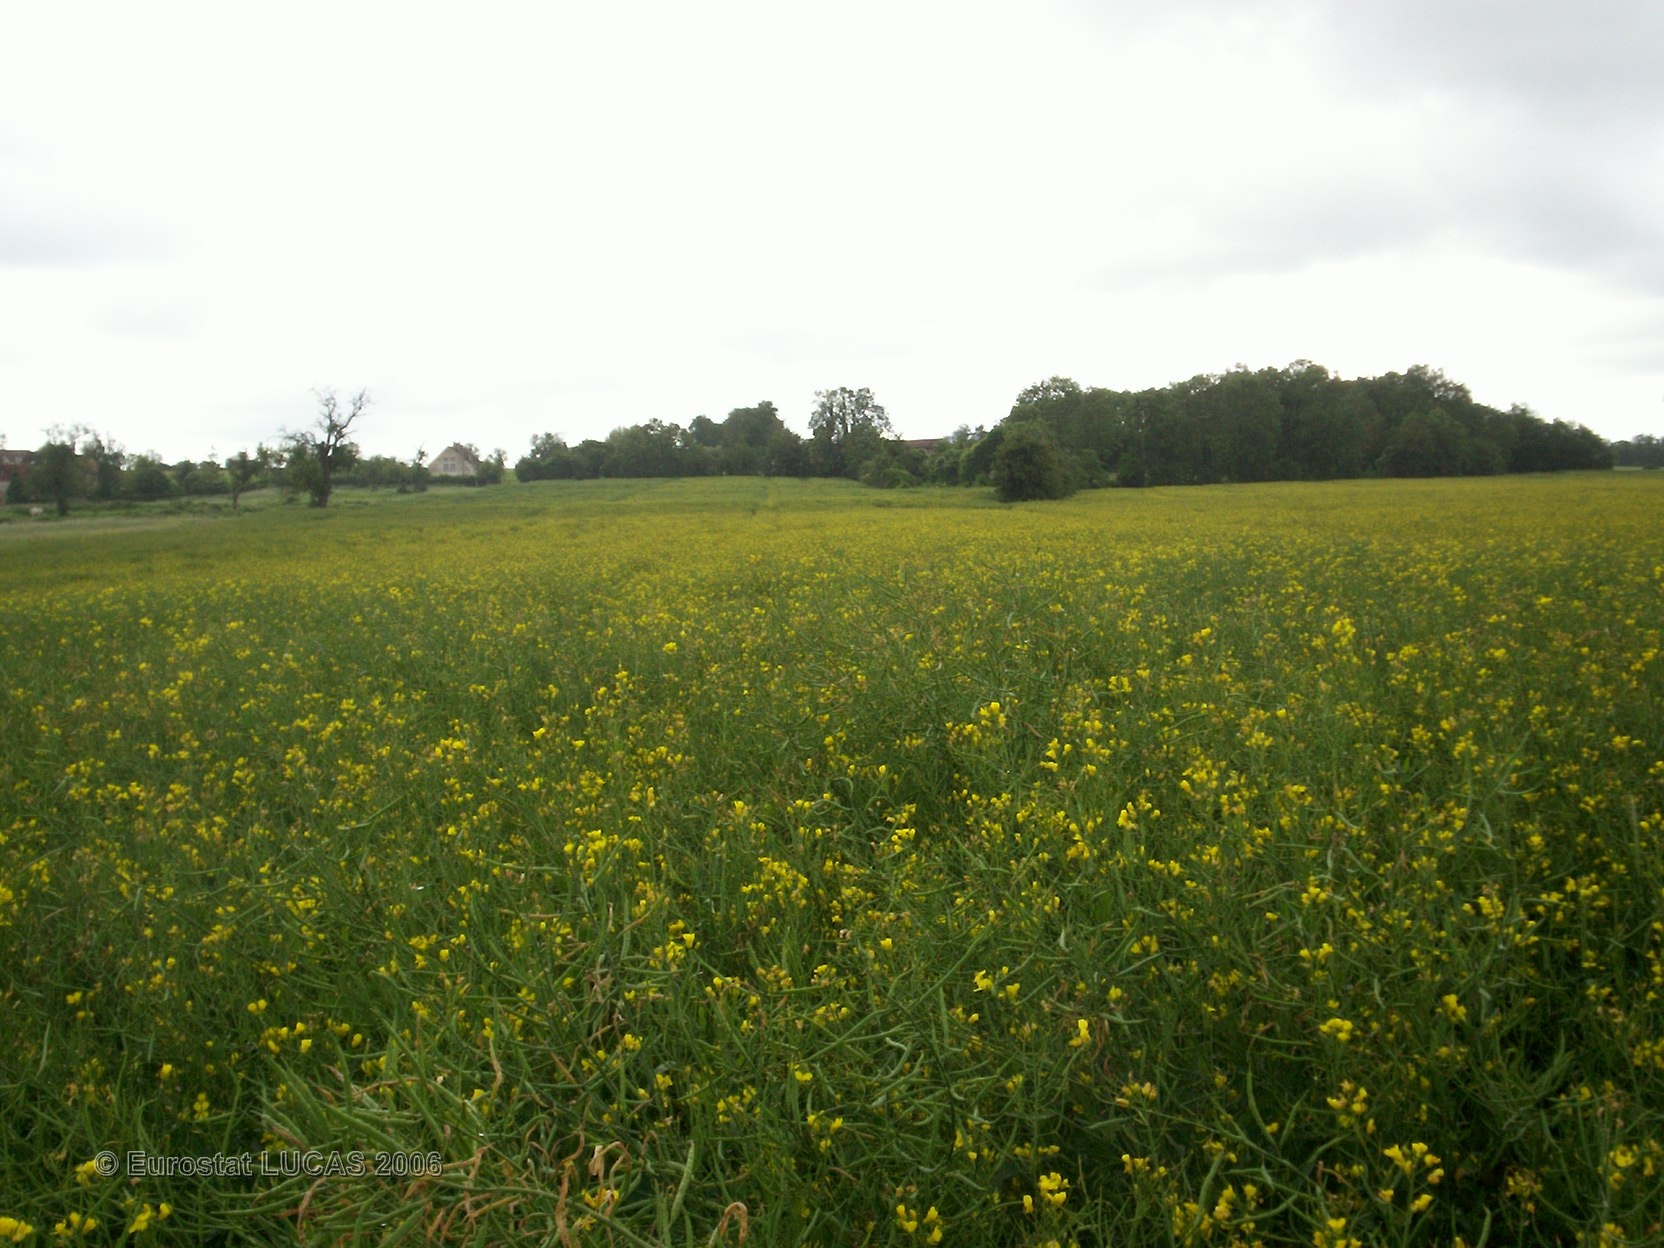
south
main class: Cropland
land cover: Rape and turnip rape
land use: Agriculture (excluding fallow land and kitchen gardens)
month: May
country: FR
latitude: 48.8751
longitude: 2.8322
